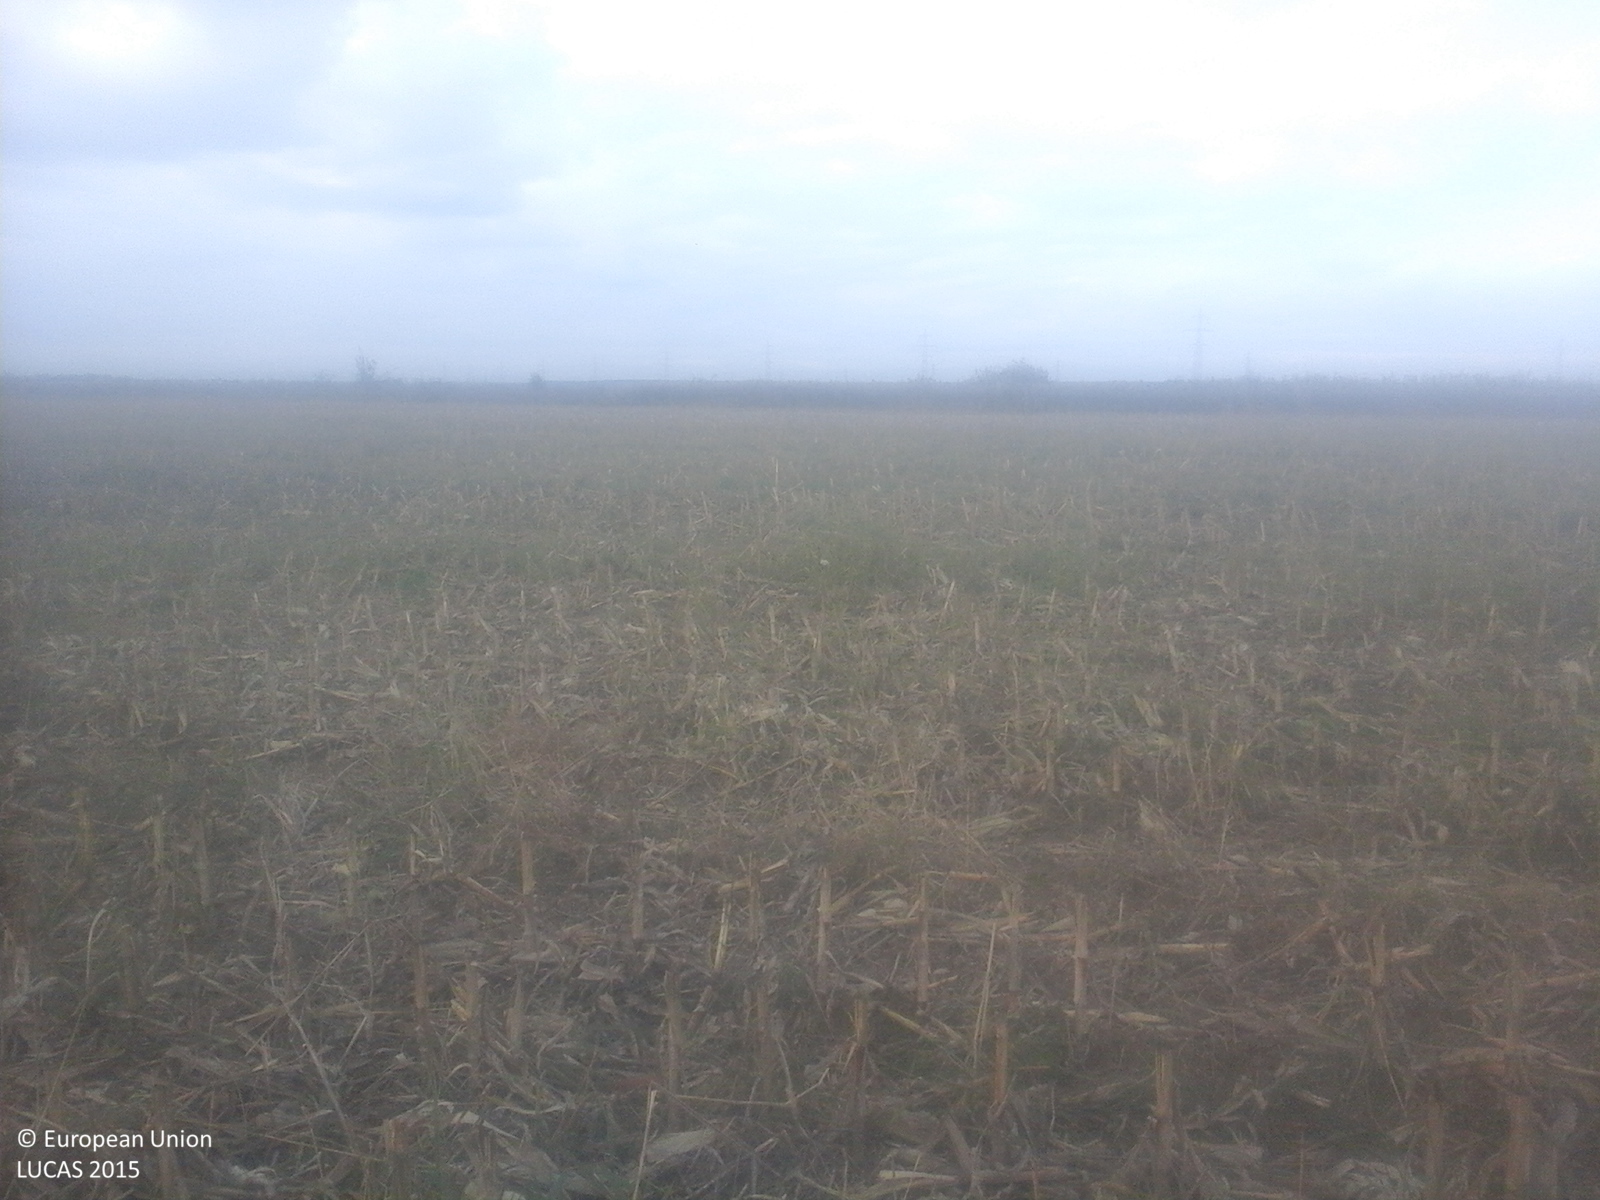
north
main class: Cropland
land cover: Maize
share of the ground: 25 - 50 %
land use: Agriculture (excluding fallow land and kitchen gardens)
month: October
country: RO
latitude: 44.7578
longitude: 25.9590
